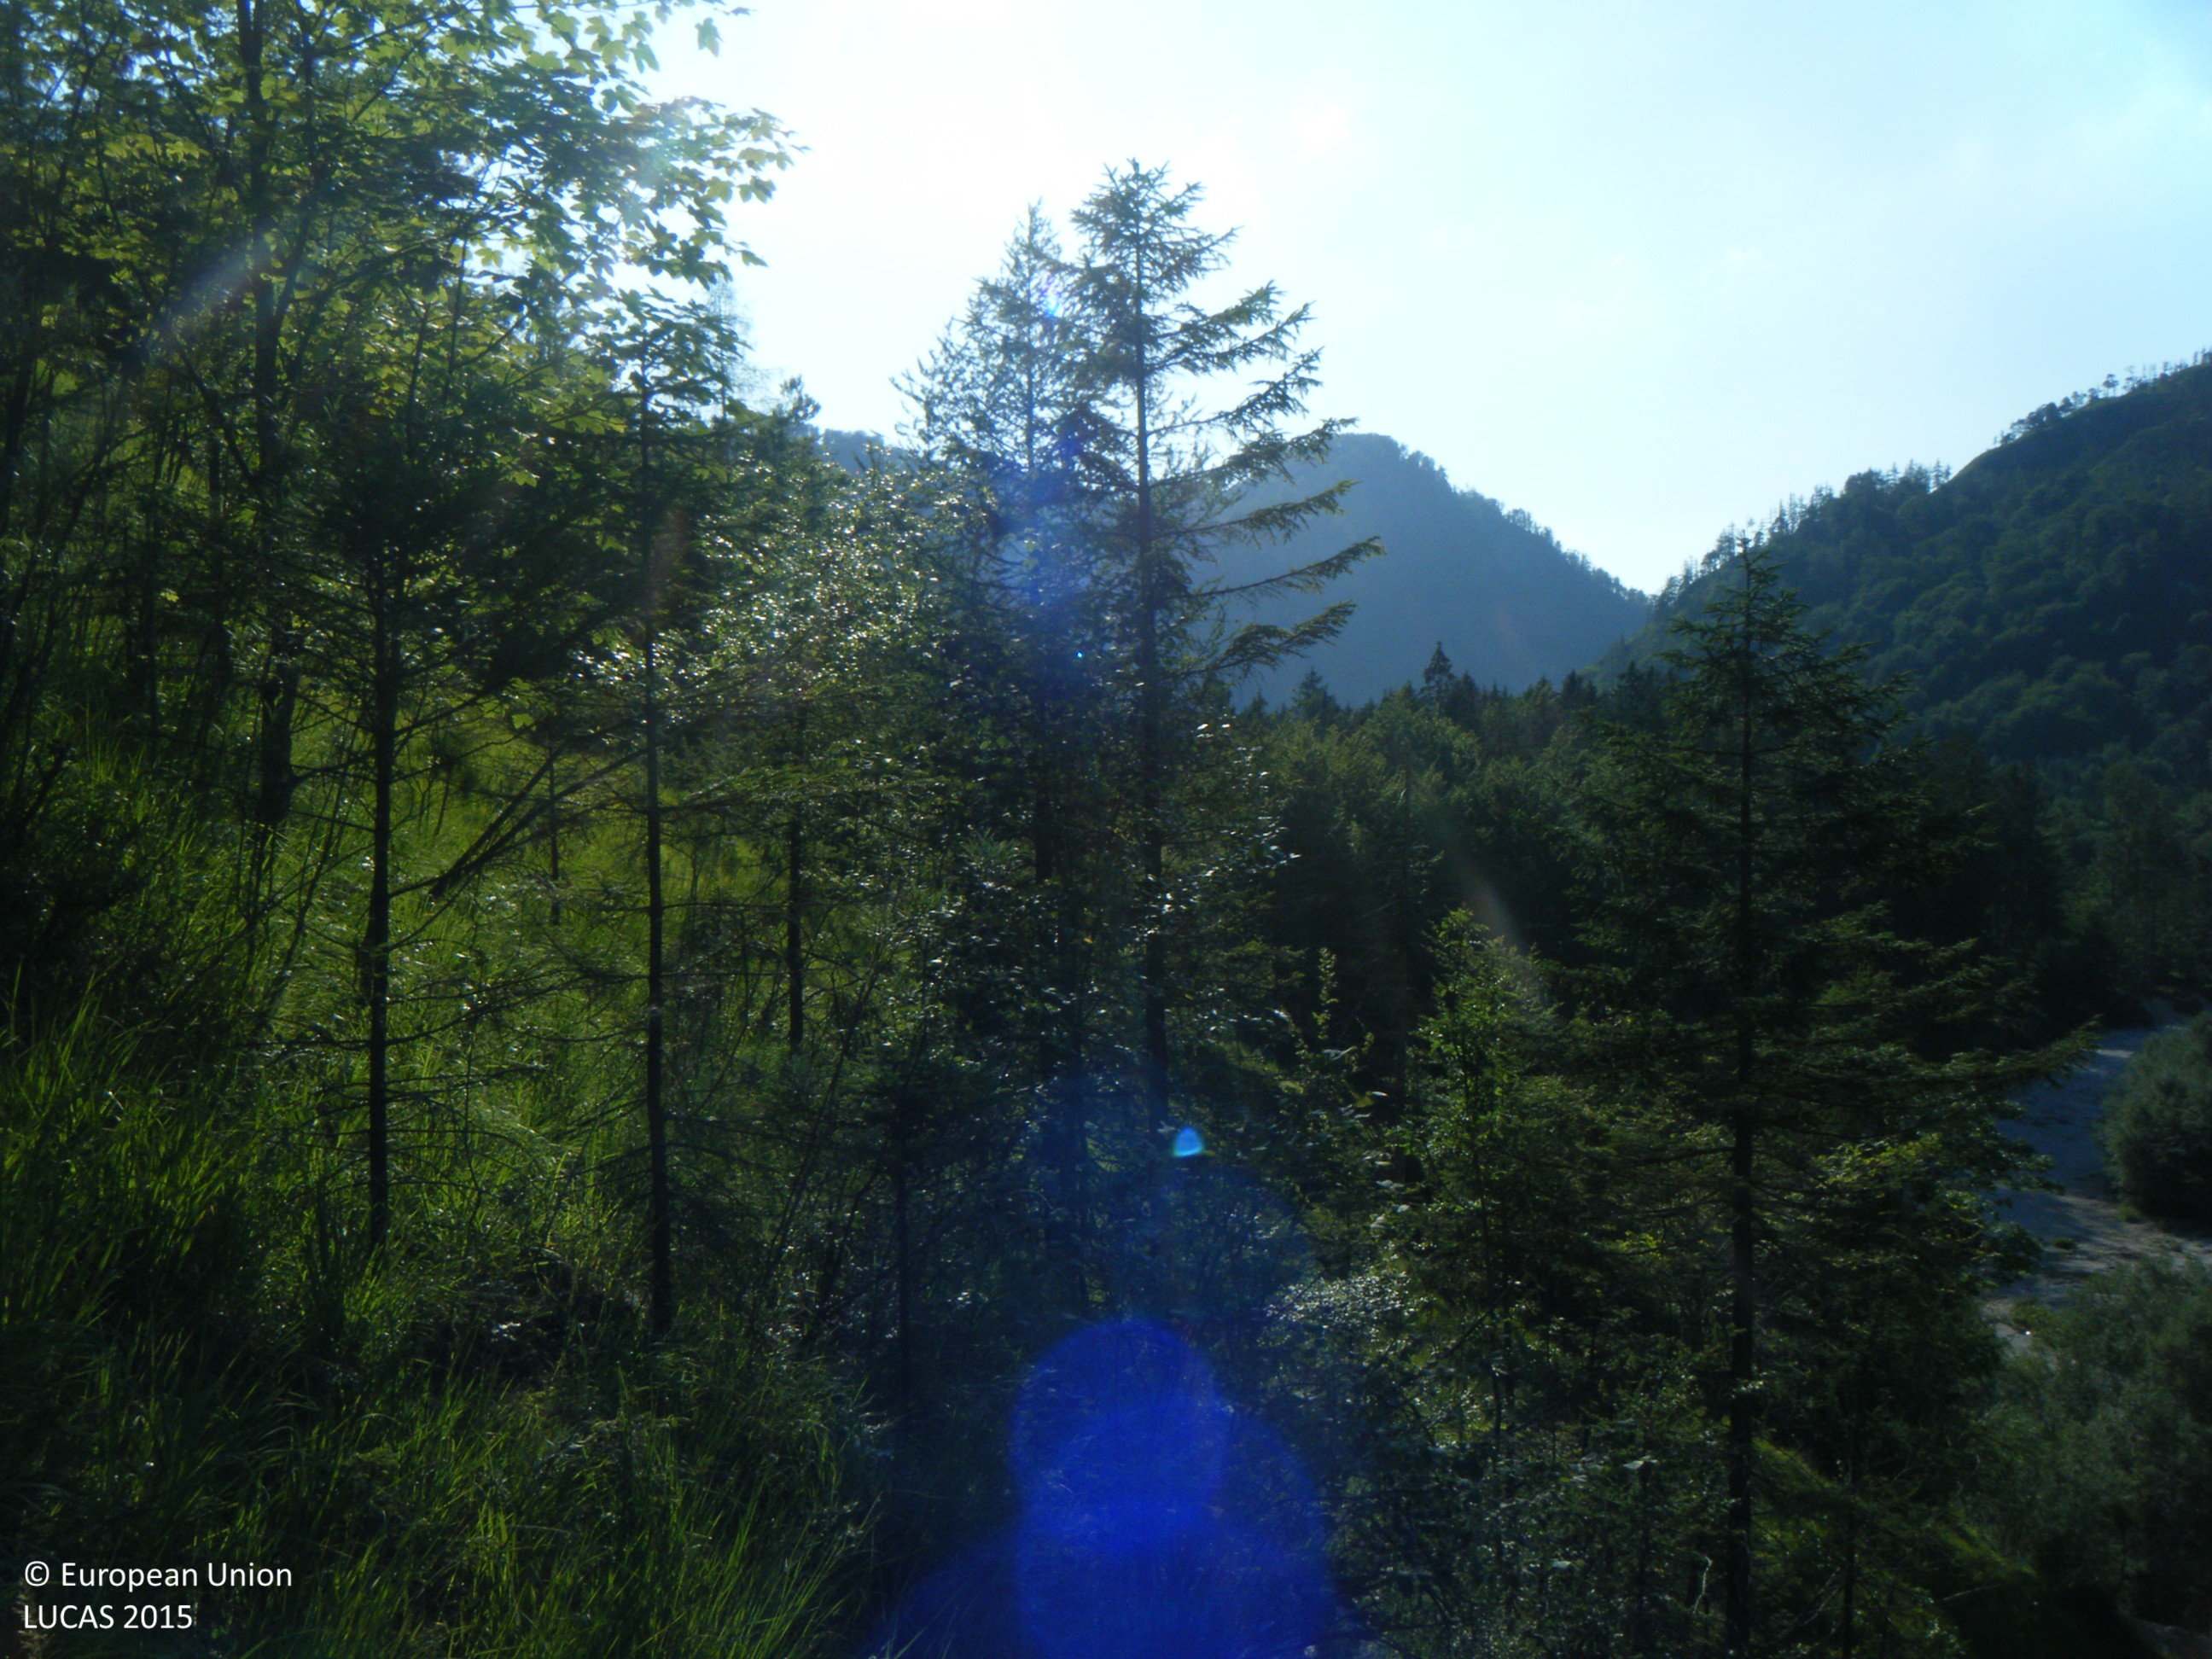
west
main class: Grassland
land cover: Grassland with sparse tree/shrub cover
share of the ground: > 75 %
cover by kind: herbaceous plants 75 %, shrubs 10 %, unconsolidated bare surface 10 %, coniferous forest trees 5 %
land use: Semi-natural and natural areas not in use
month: July
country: AT
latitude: 47.7877
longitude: 13.5627
